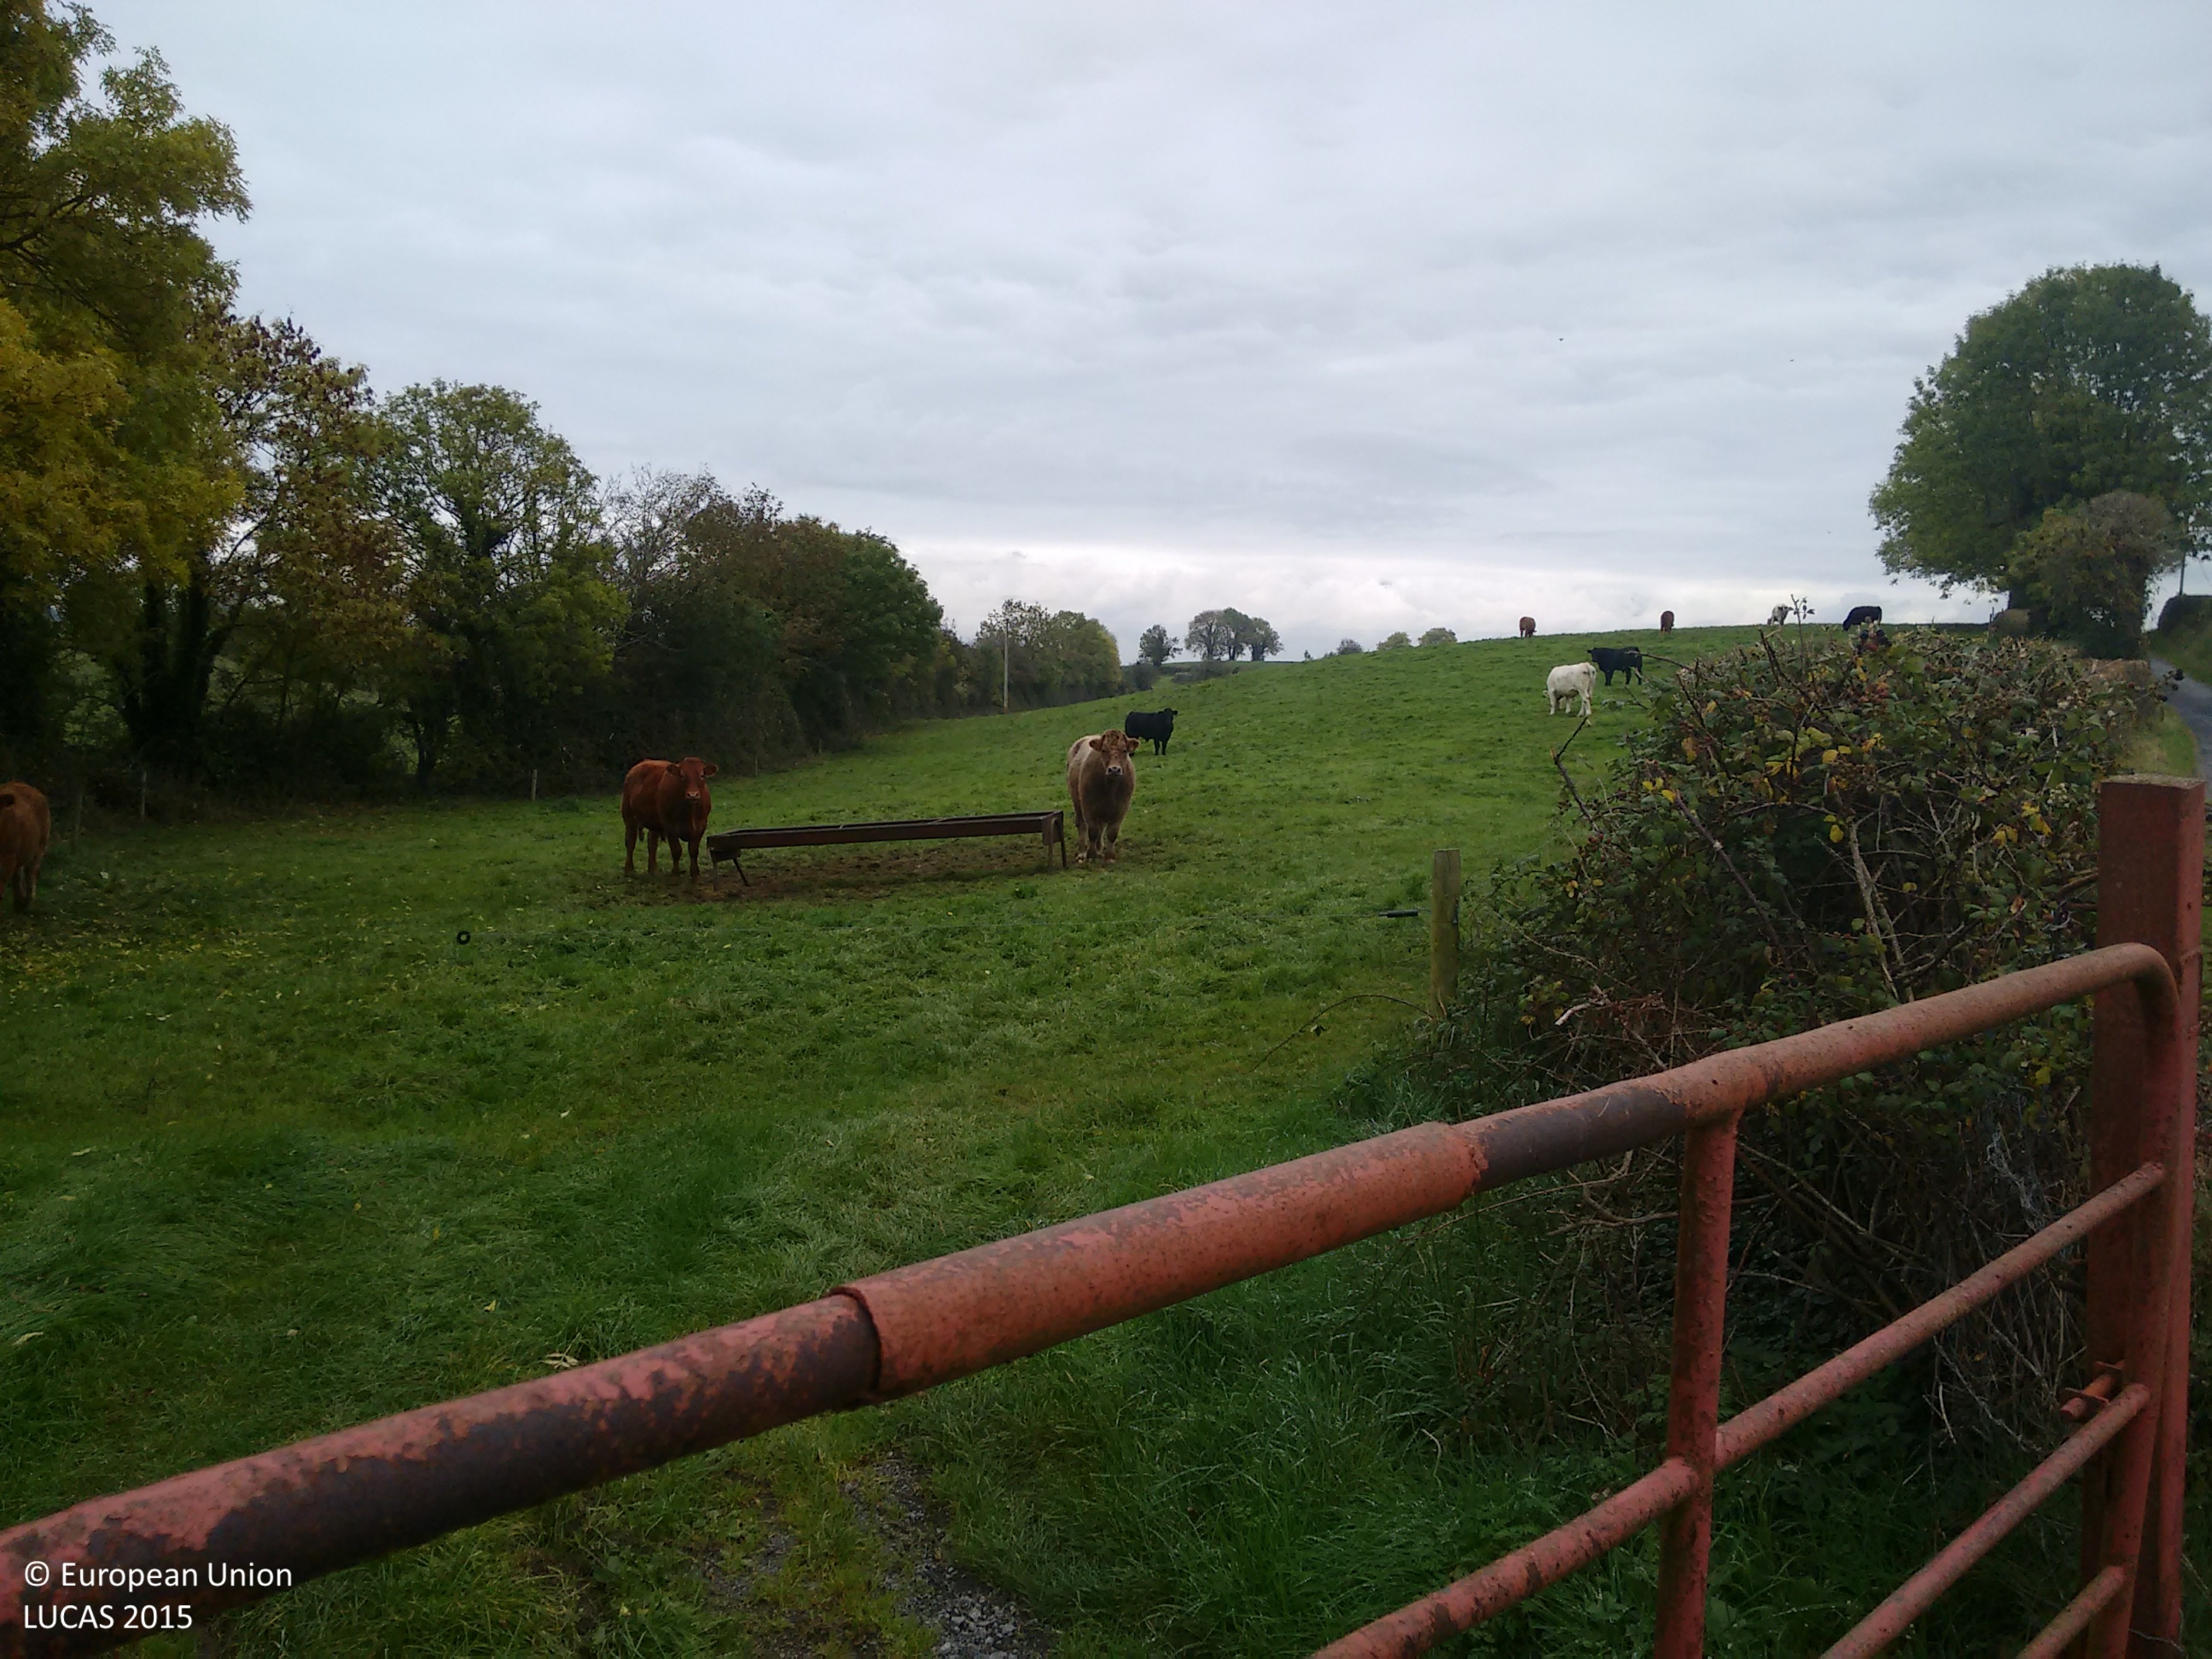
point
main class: Grassland
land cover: Grassland without tree/shrub cover
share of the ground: > 75 %
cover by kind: herbaceous plants 95 %
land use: Agriculture (excluding fallow land and kitchen gardens)
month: October
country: IE
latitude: 52.8125
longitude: -7.5025
